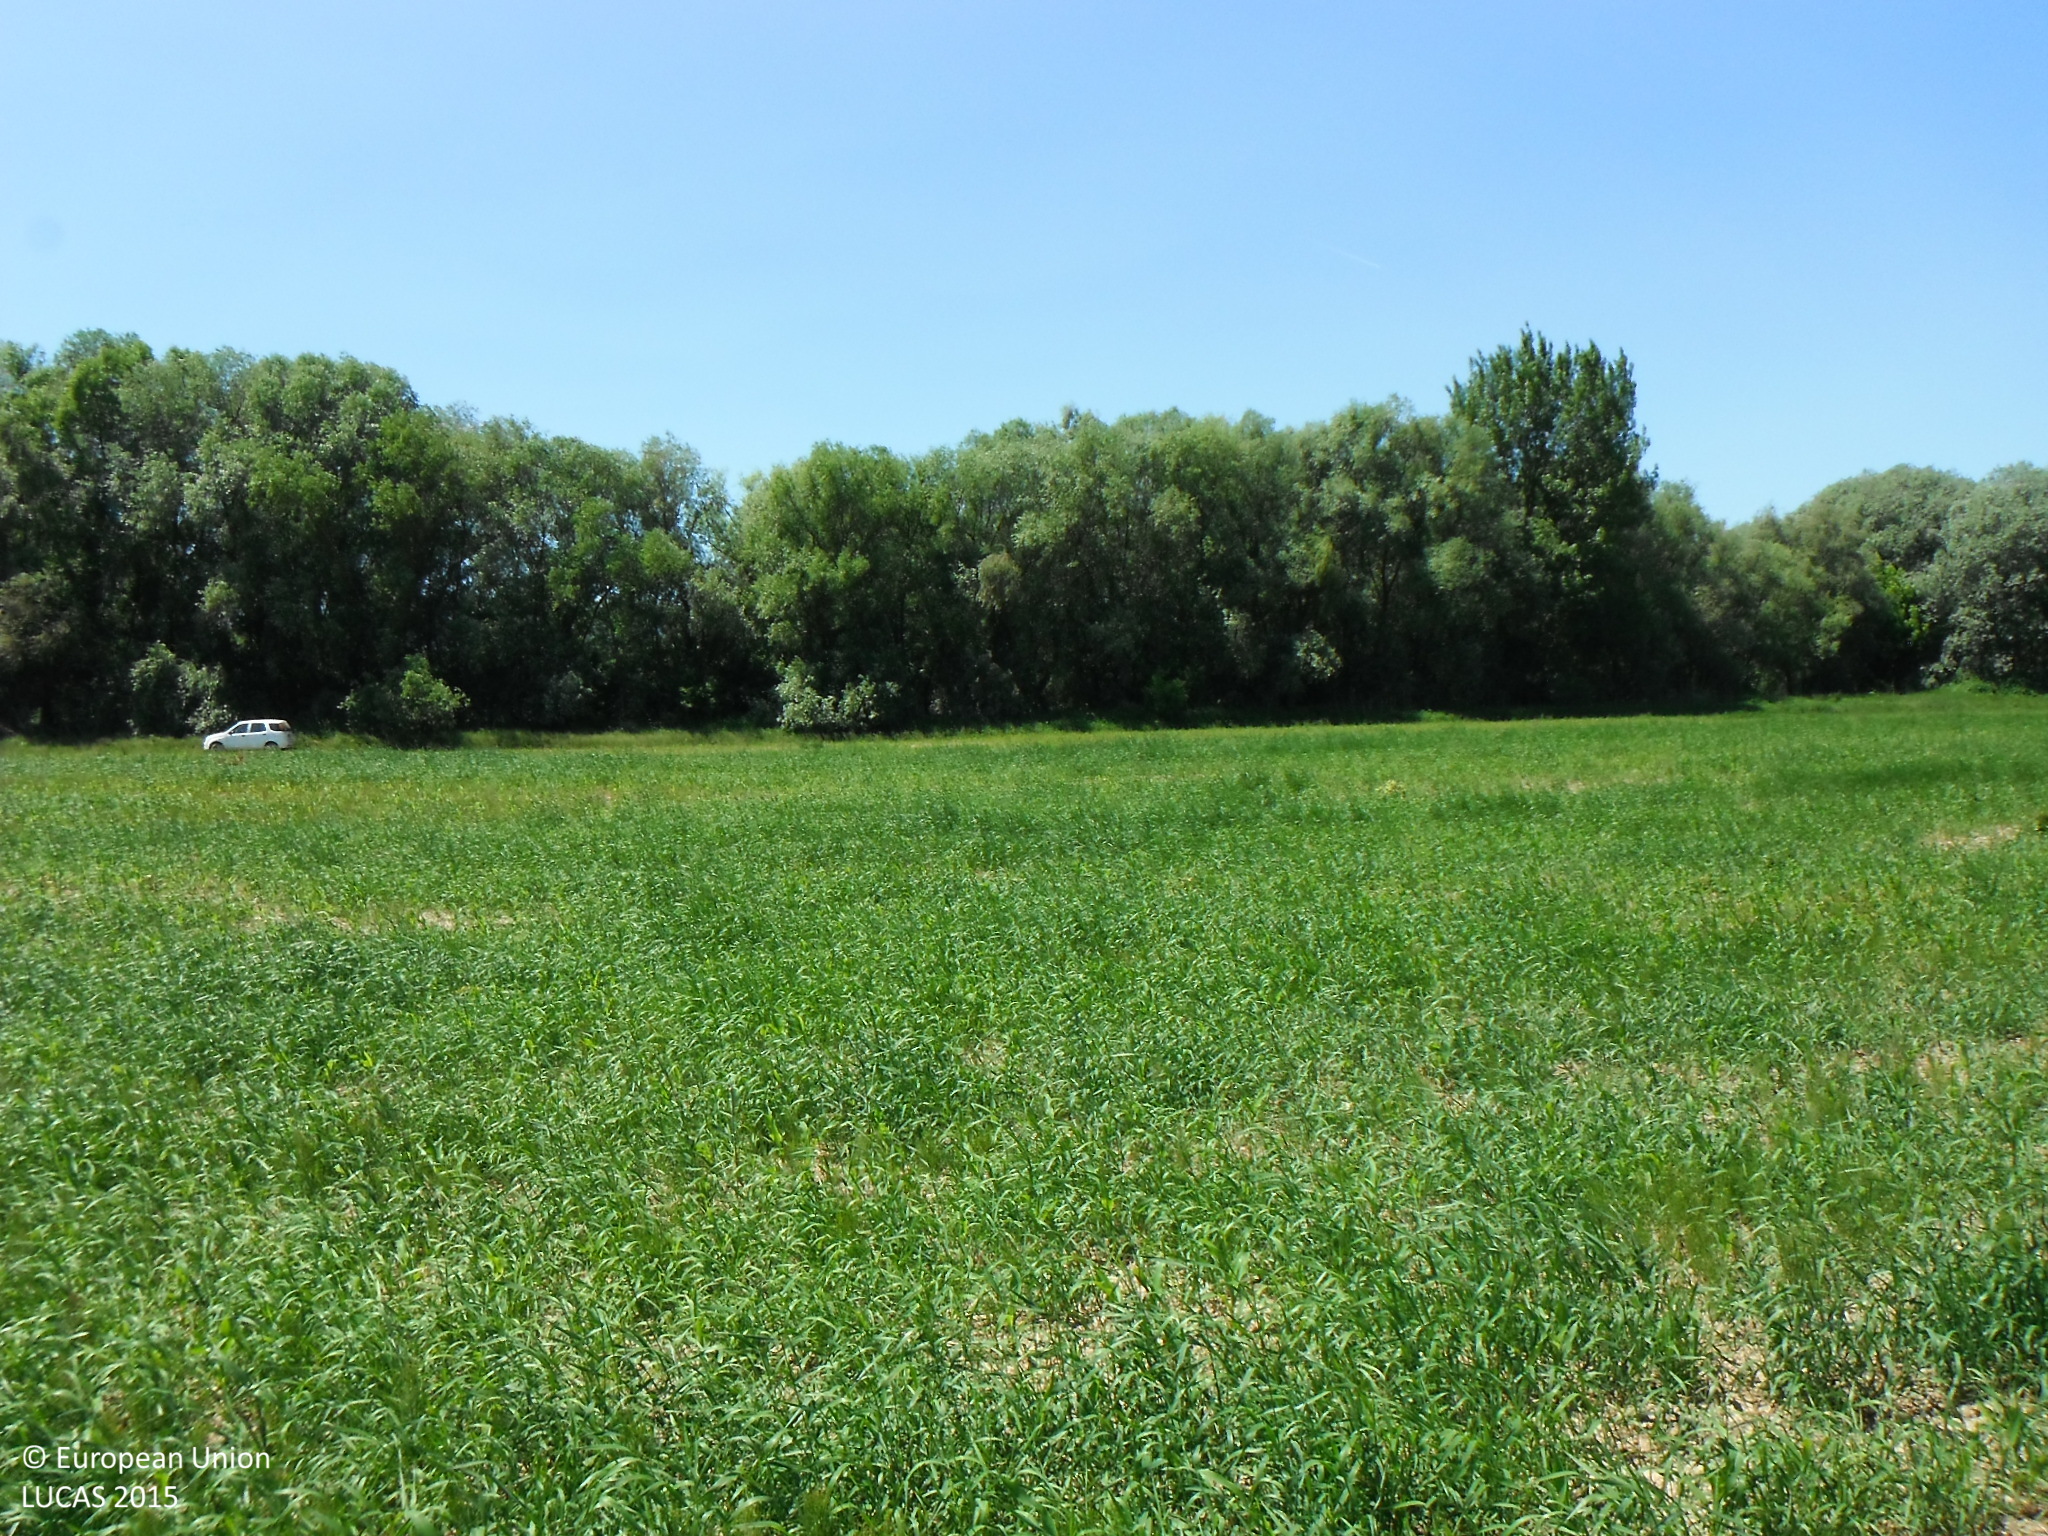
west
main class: Cropland
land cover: Maize
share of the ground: 10 - 25 %
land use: Agriculture (excluding fallow land and kitchen gardens)
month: June
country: SK
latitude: 48.8204
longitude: 21.3090
